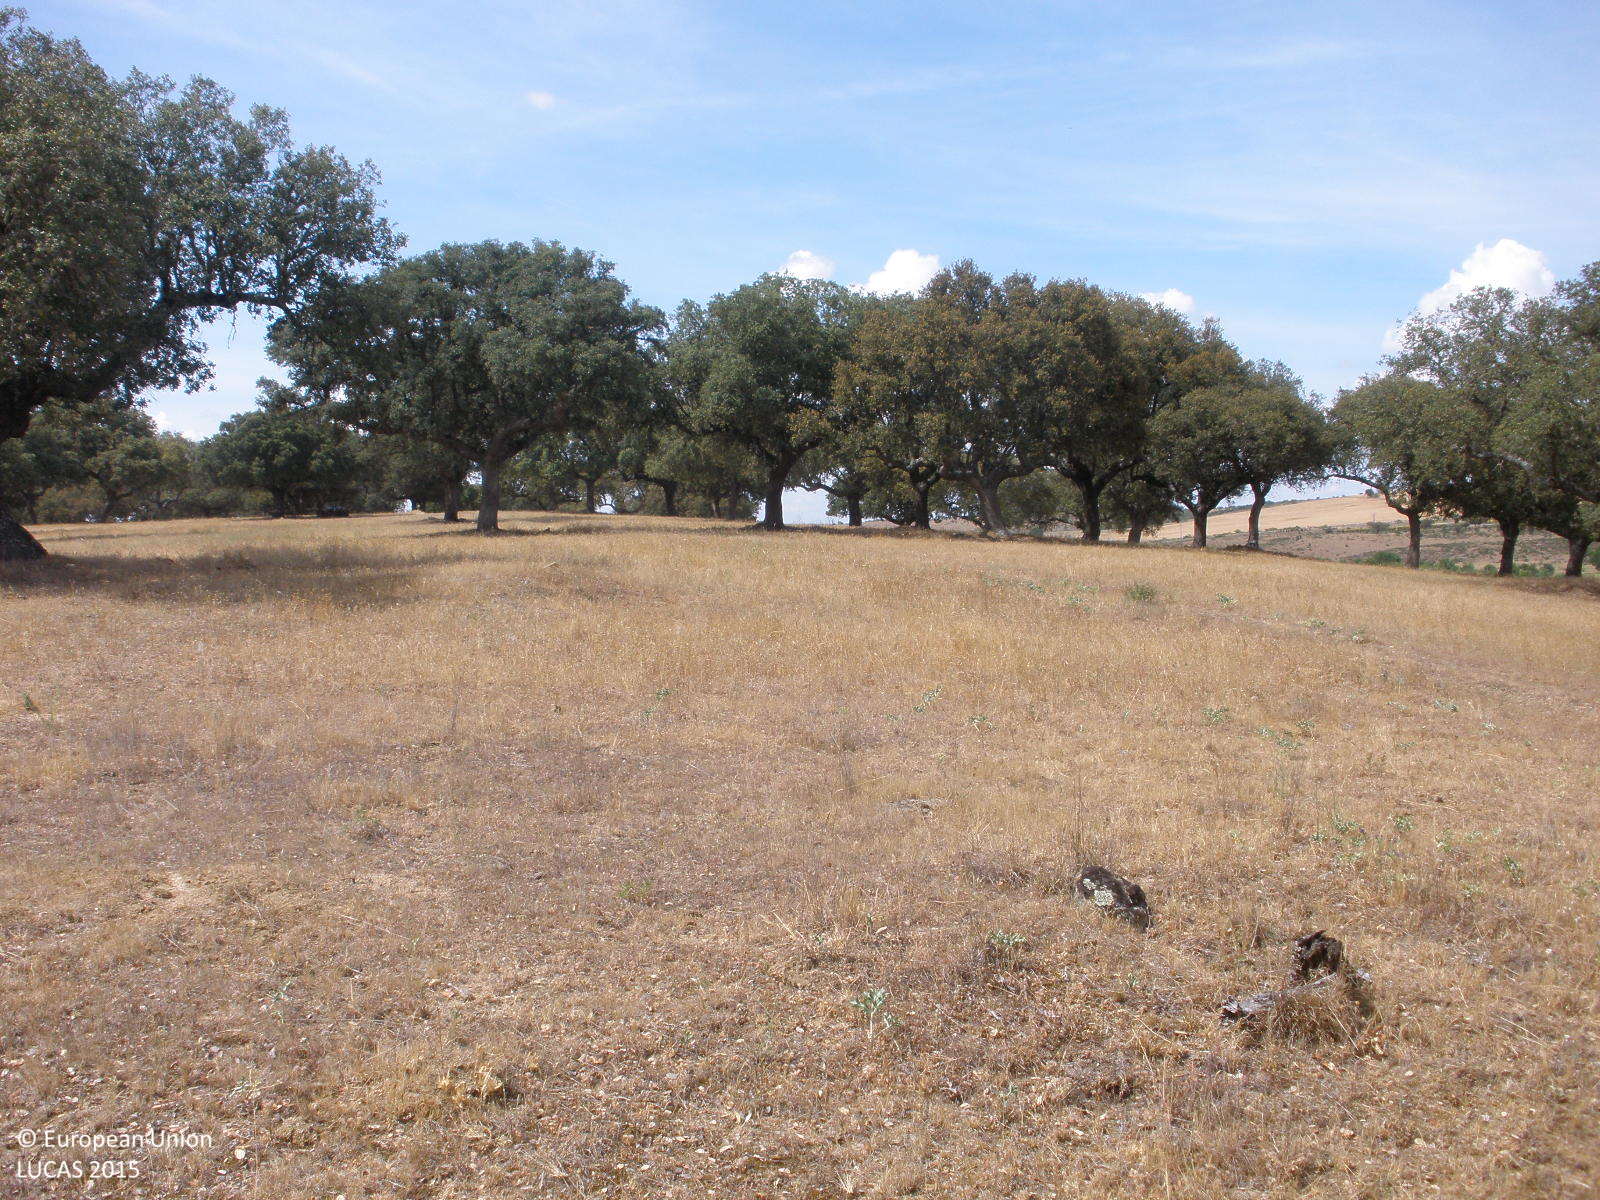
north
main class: Woodland
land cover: Broadleaved woodland
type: broadleaved evergreen forest
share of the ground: 25 - 50 %
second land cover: Grassland without tree/shrub cover
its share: > 75 %
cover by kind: herbaceous plants 60 %, broadleaved forest trees 40 %
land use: Forestry
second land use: Agriculture (excluding fallow land and kitchen gardens)
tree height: > 5 m
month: June
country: ES
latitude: 40.5804
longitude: -6.6674
